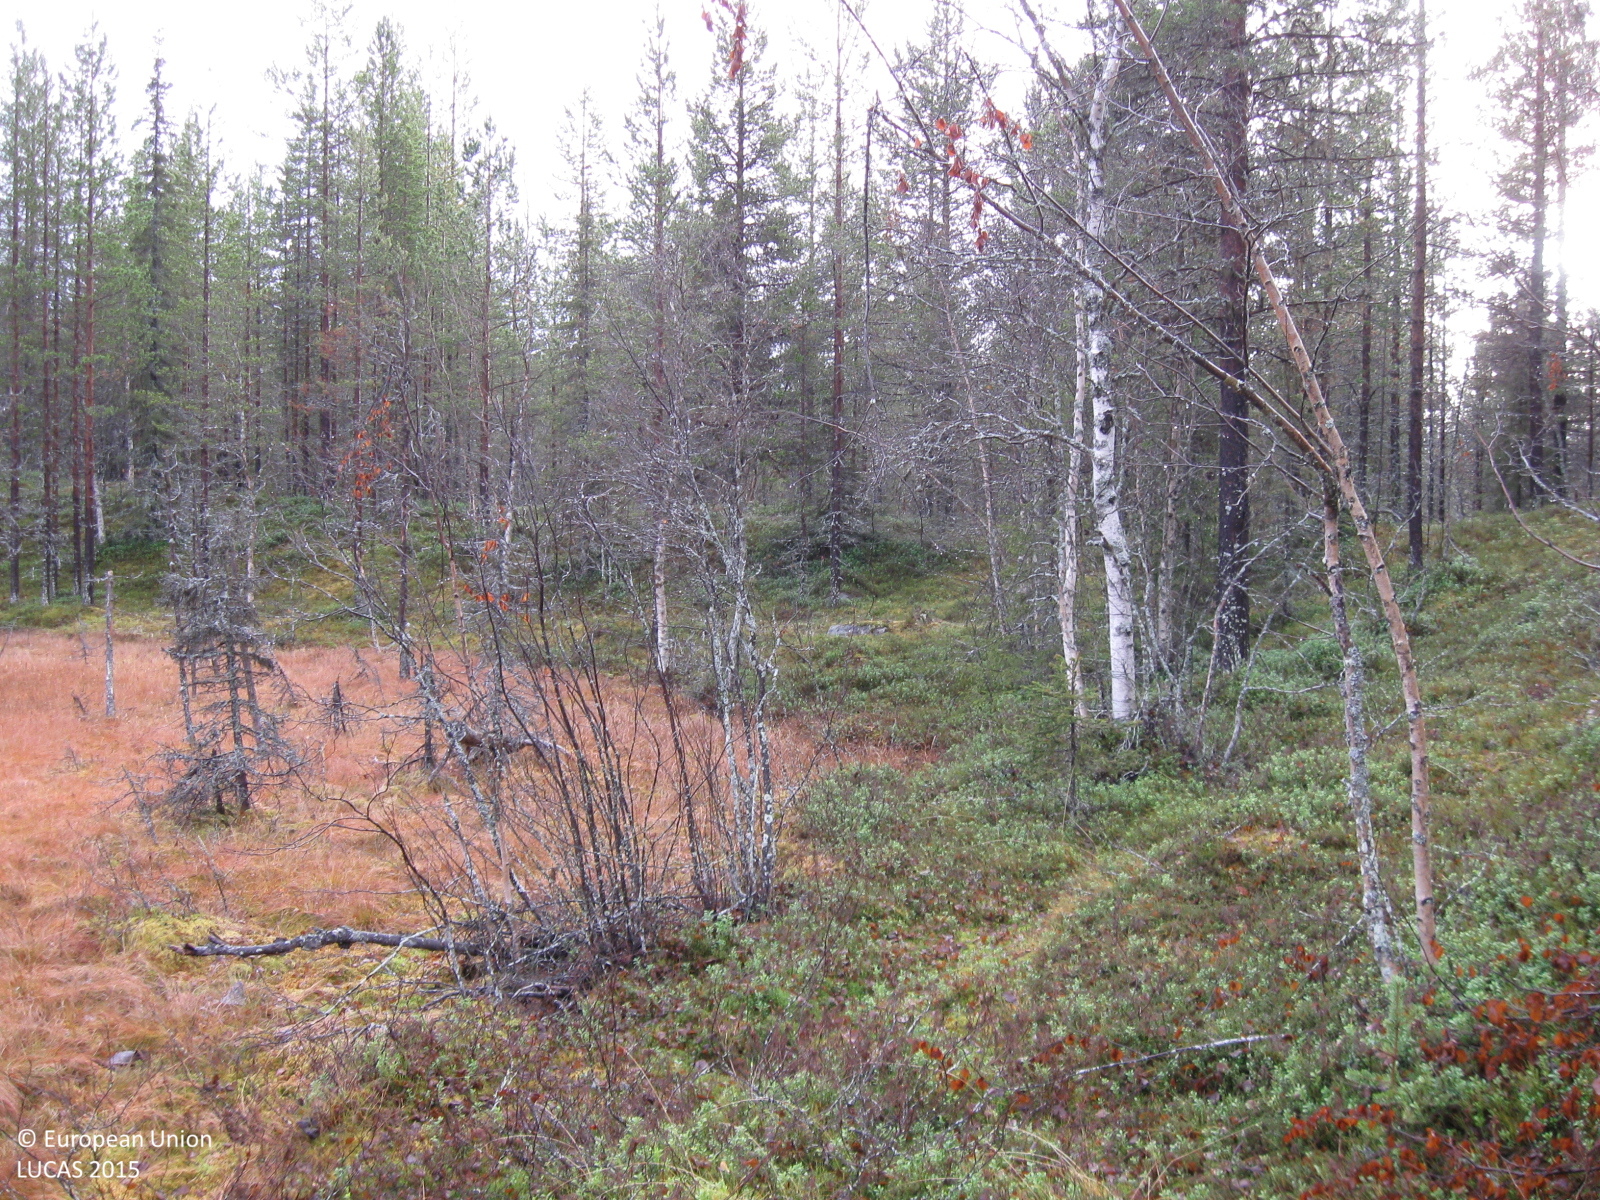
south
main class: Woodland
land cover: Pine dominated mixed woodland
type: boreal forest
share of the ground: 25 - 50 %
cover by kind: herbaceous plants 25 %, coniferous forest trees 20 %, broadleaved forest trees 20 %, shrubs 20 %, lichens and mosses 15 %
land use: Forestry
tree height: > 5 m
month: October
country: SE
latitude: 66.8289
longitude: 21.0466
